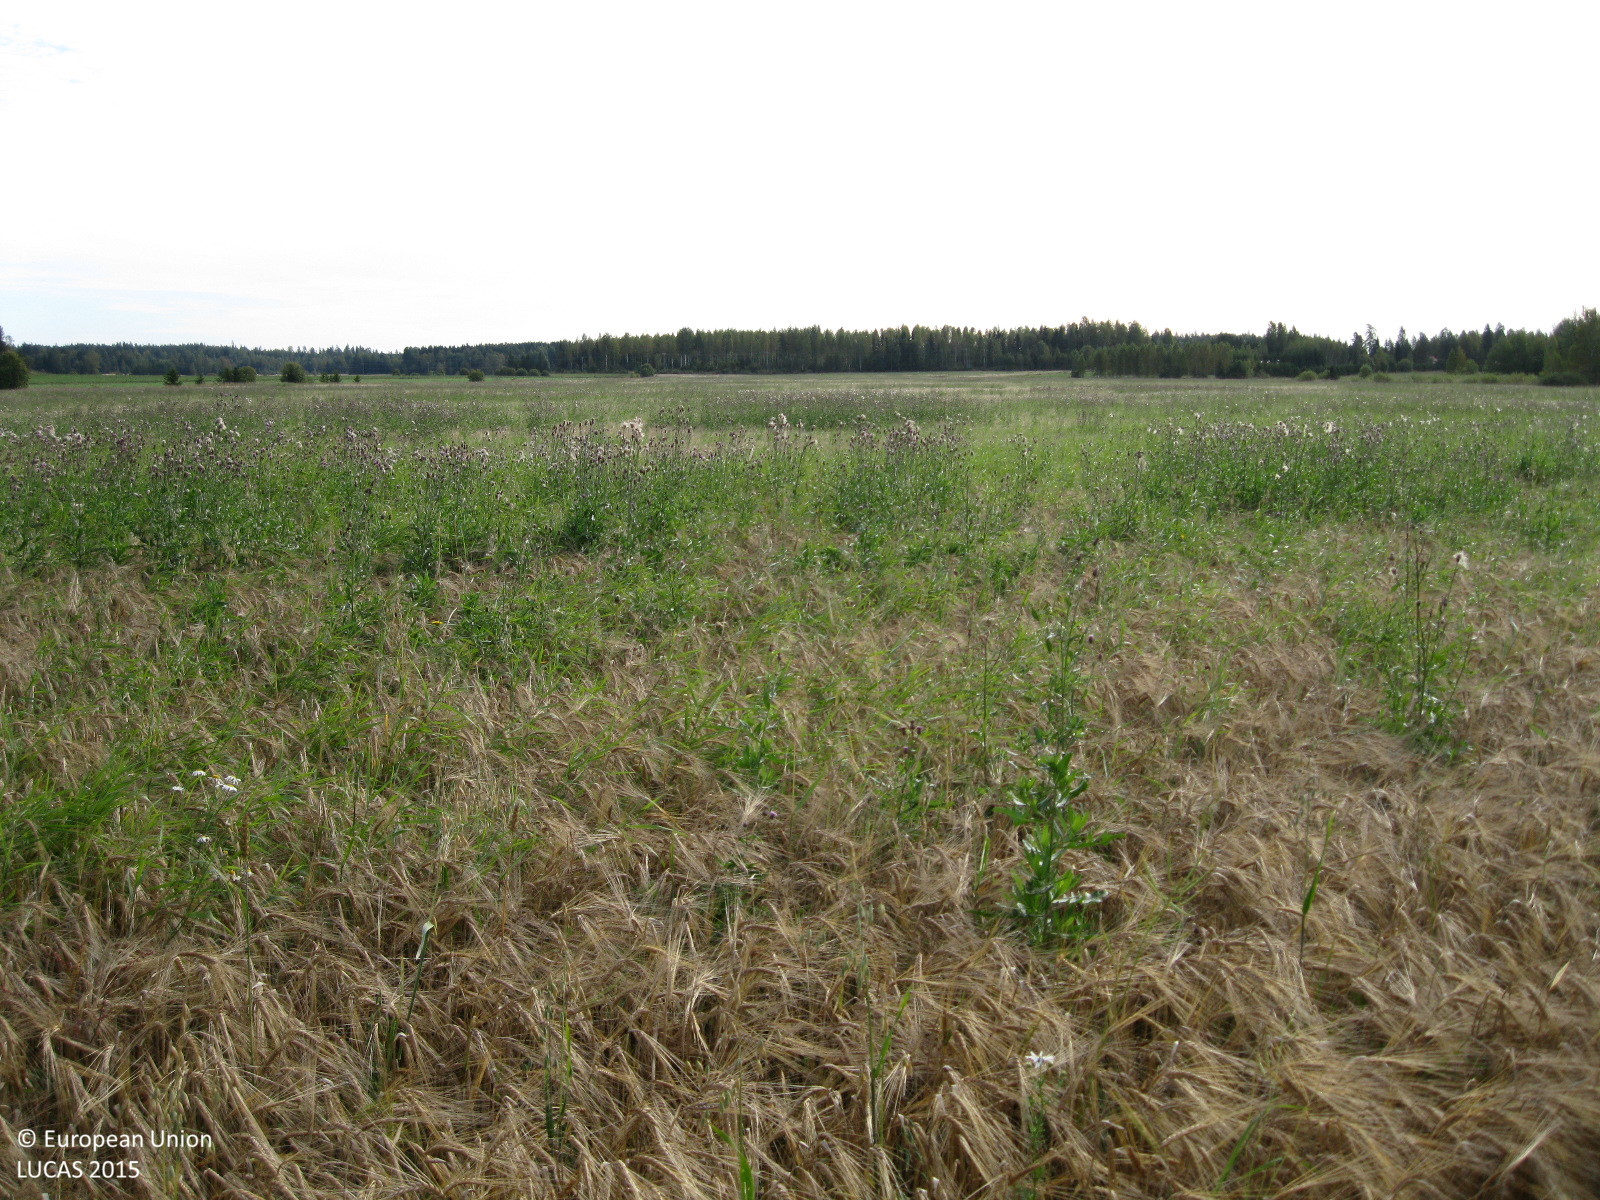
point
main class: Cropland
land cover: Barley
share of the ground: > 75 %
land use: Agriculture (excluding fallow land and kitchen gardens)
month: September
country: FI
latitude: 60.5931
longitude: 24.9221
